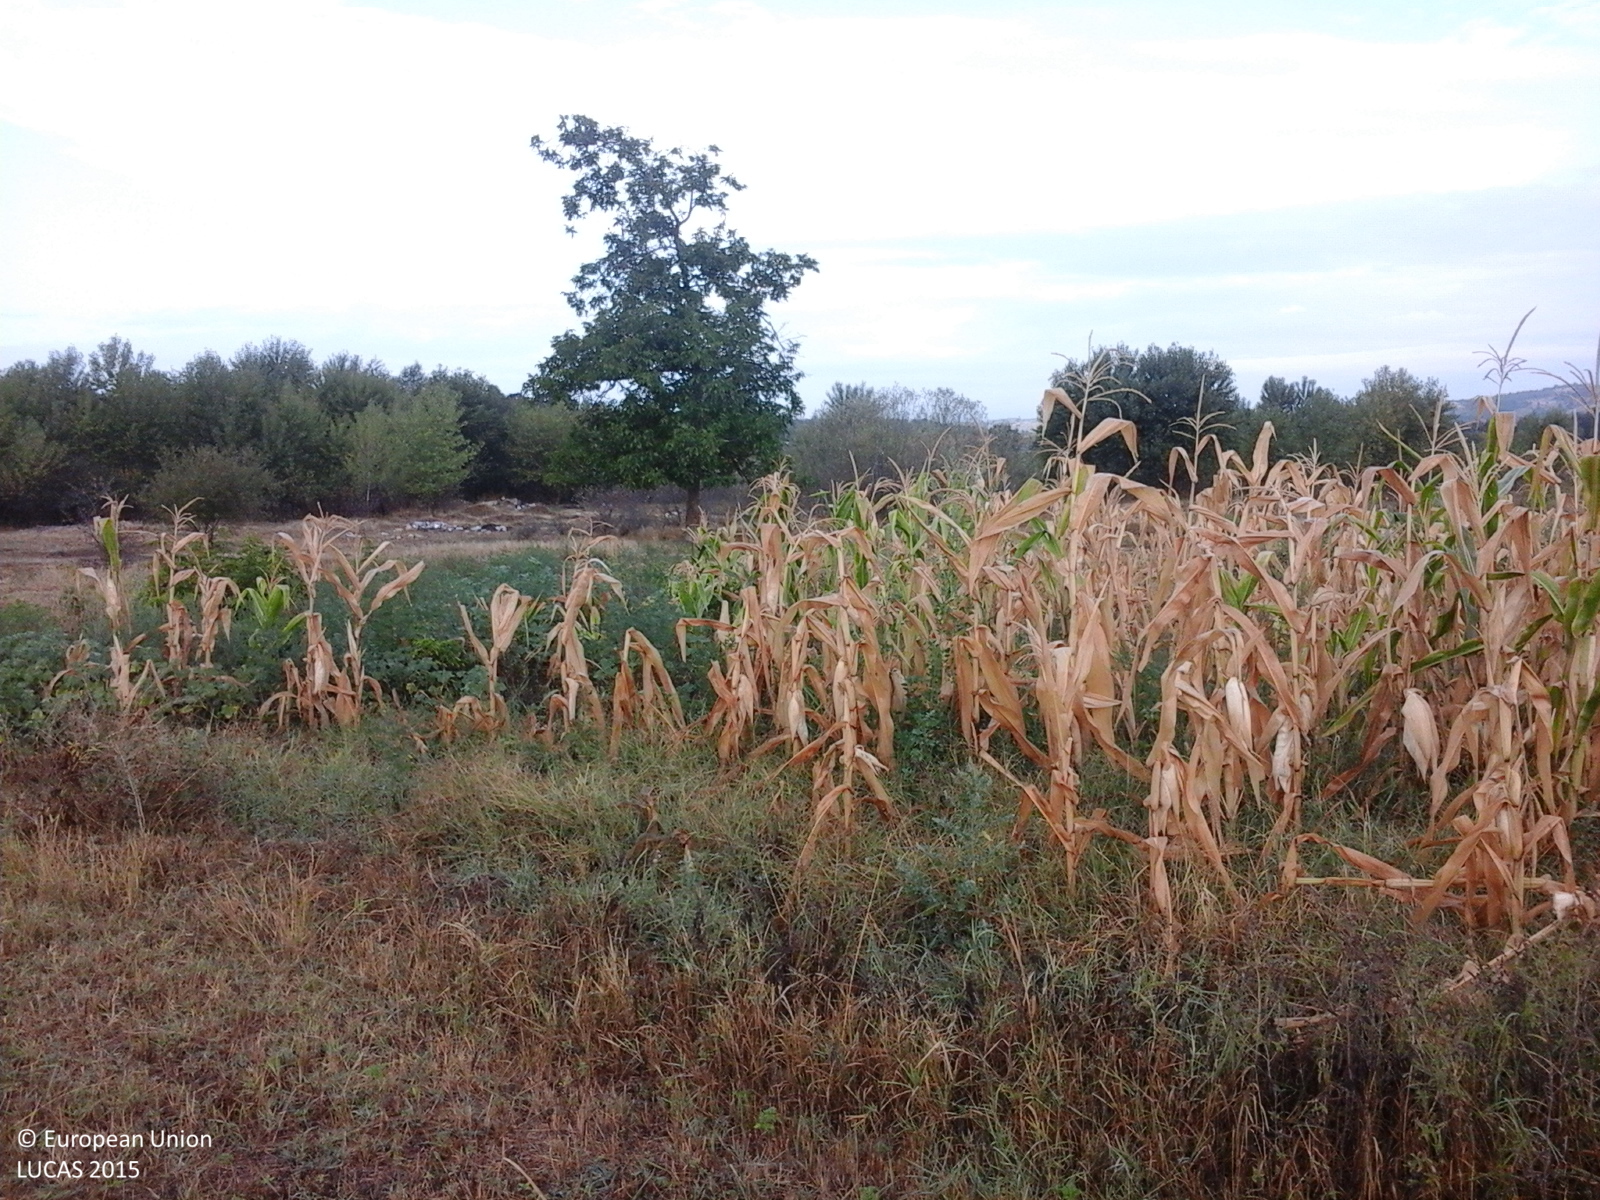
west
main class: Grassland
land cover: Grassland without tree/shrub cover
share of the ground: > 75 %
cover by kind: herbaceous plants 100 %
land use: Agriculture (excluding fallow land and kitchen gardens)
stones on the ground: < 10 %
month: August
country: RO
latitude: 44.7005
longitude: 22.6752
